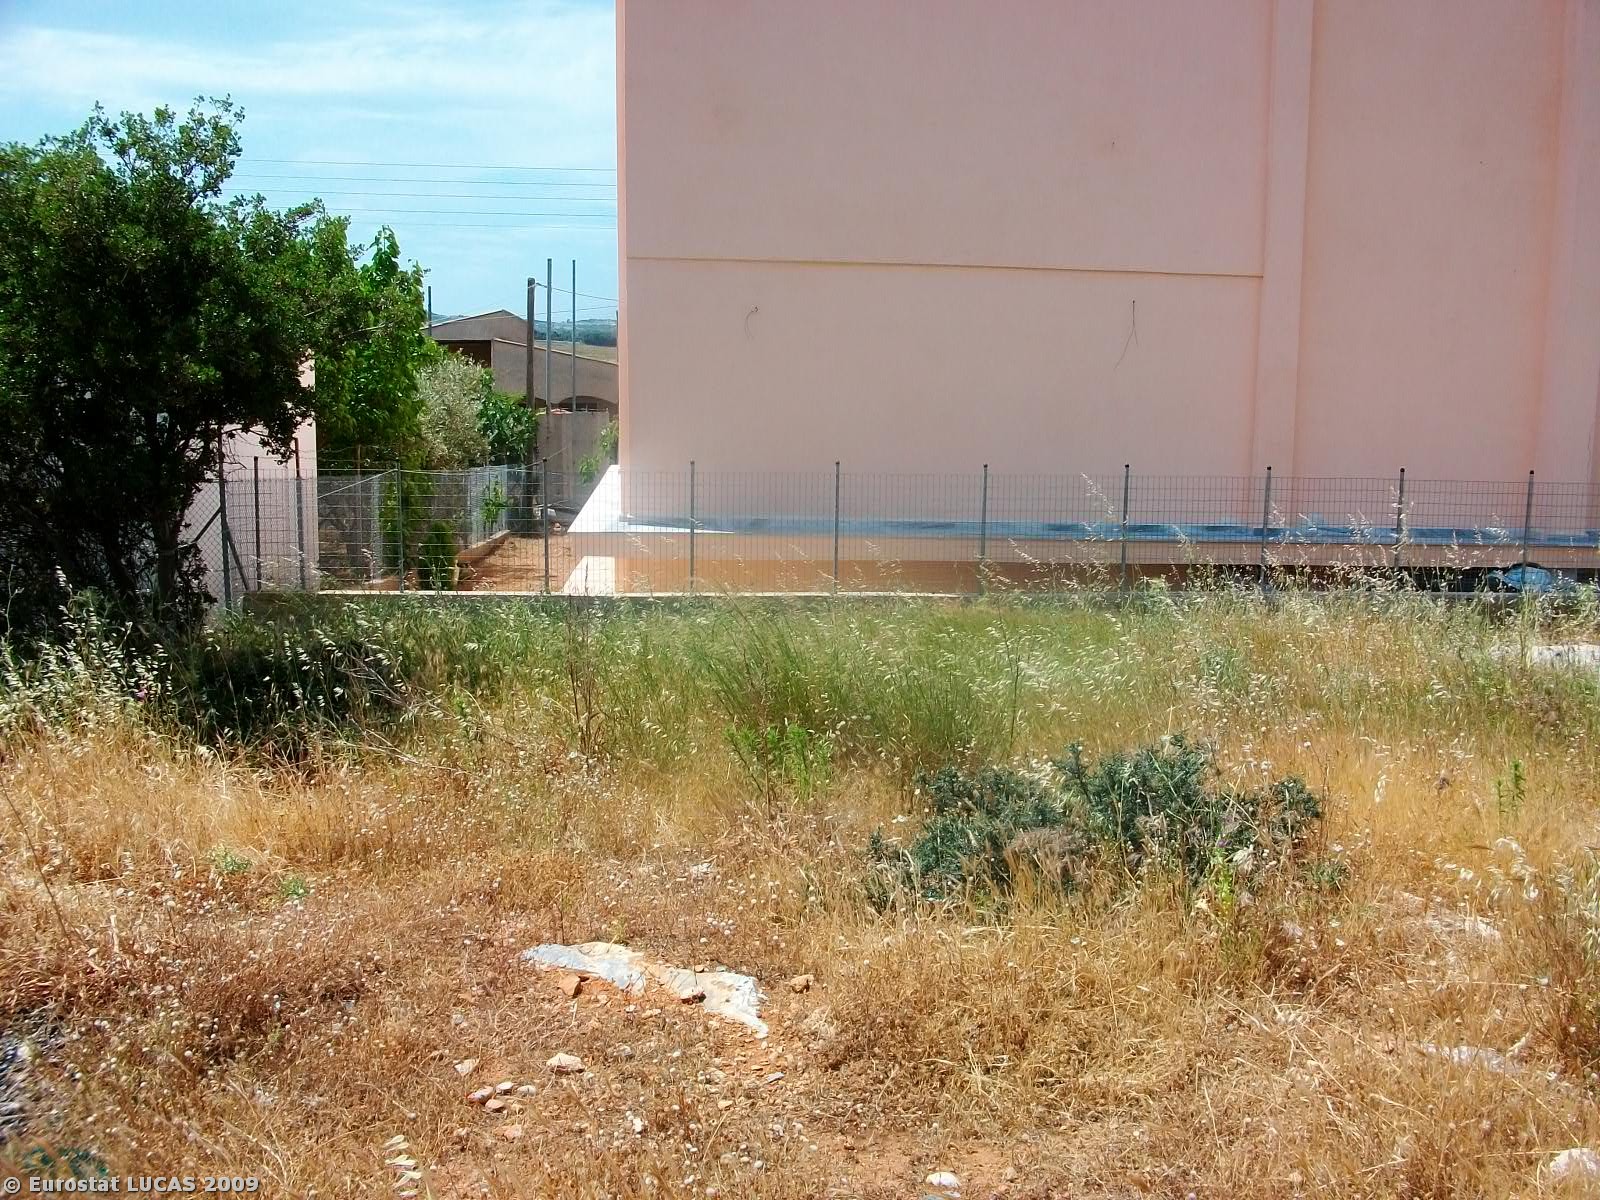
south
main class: Grassland
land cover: Spontaneously vegetated surfaces
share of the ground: > 75 %
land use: Unused
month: May
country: GR
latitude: 37.9405
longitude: 23.8519
